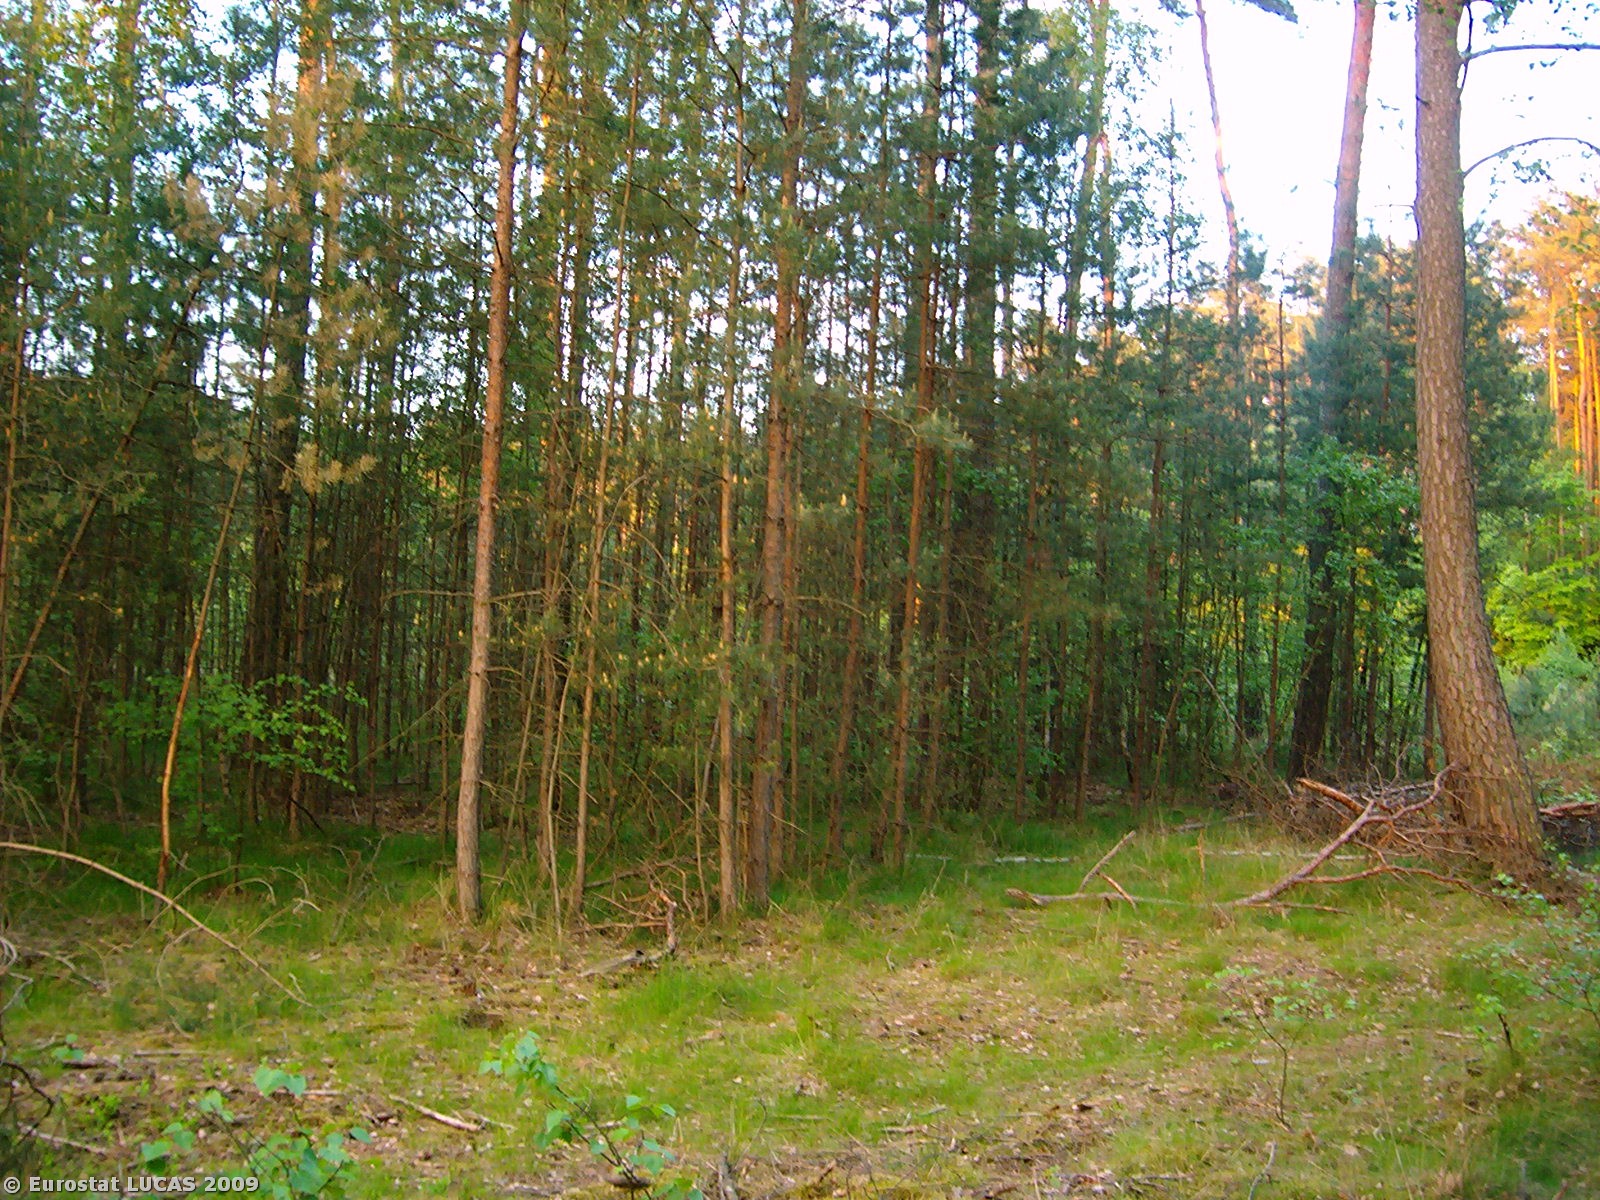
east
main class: Woodland
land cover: Mixed woodland
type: hemiboreal forest and nemoral coniferous forest and mixed broadleaved-coniferous forest
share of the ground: 50 - 75 %
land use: Forestry
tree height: > 5 m
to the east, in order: Mixed woodland; Grassland with sparse tree/shrub cover; Mixed woodland; Shrubland without tree cover; Paved roads, cycling and walking lanes; Mixed woodland
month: May
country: PL
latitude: 52.5836
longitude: 16.3976
